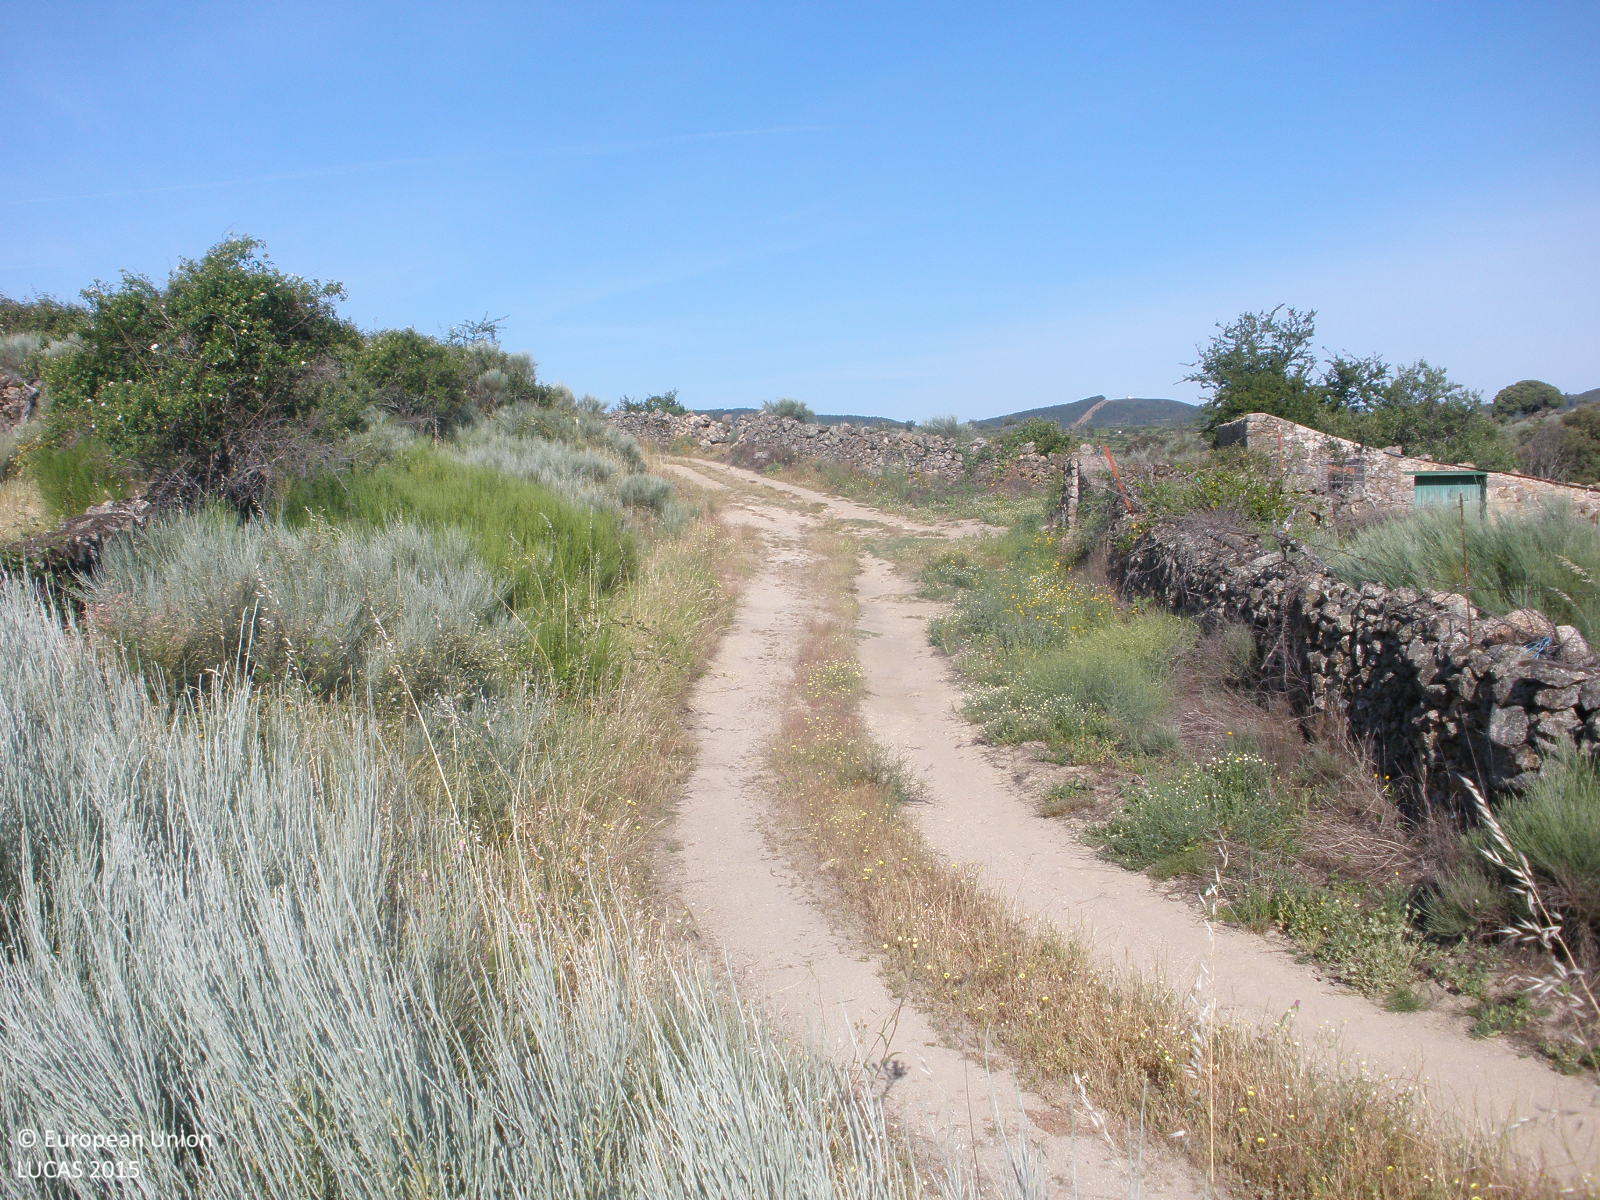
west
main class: Grassland
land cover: Grassland without tree/shrub cover
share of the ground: > 75 %
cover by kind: herbaceous plants 100 %
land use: Agriculture (excluding fallow land and kitchen gardens)
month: May
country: ES
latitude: 40.1046
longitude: -6.7568
